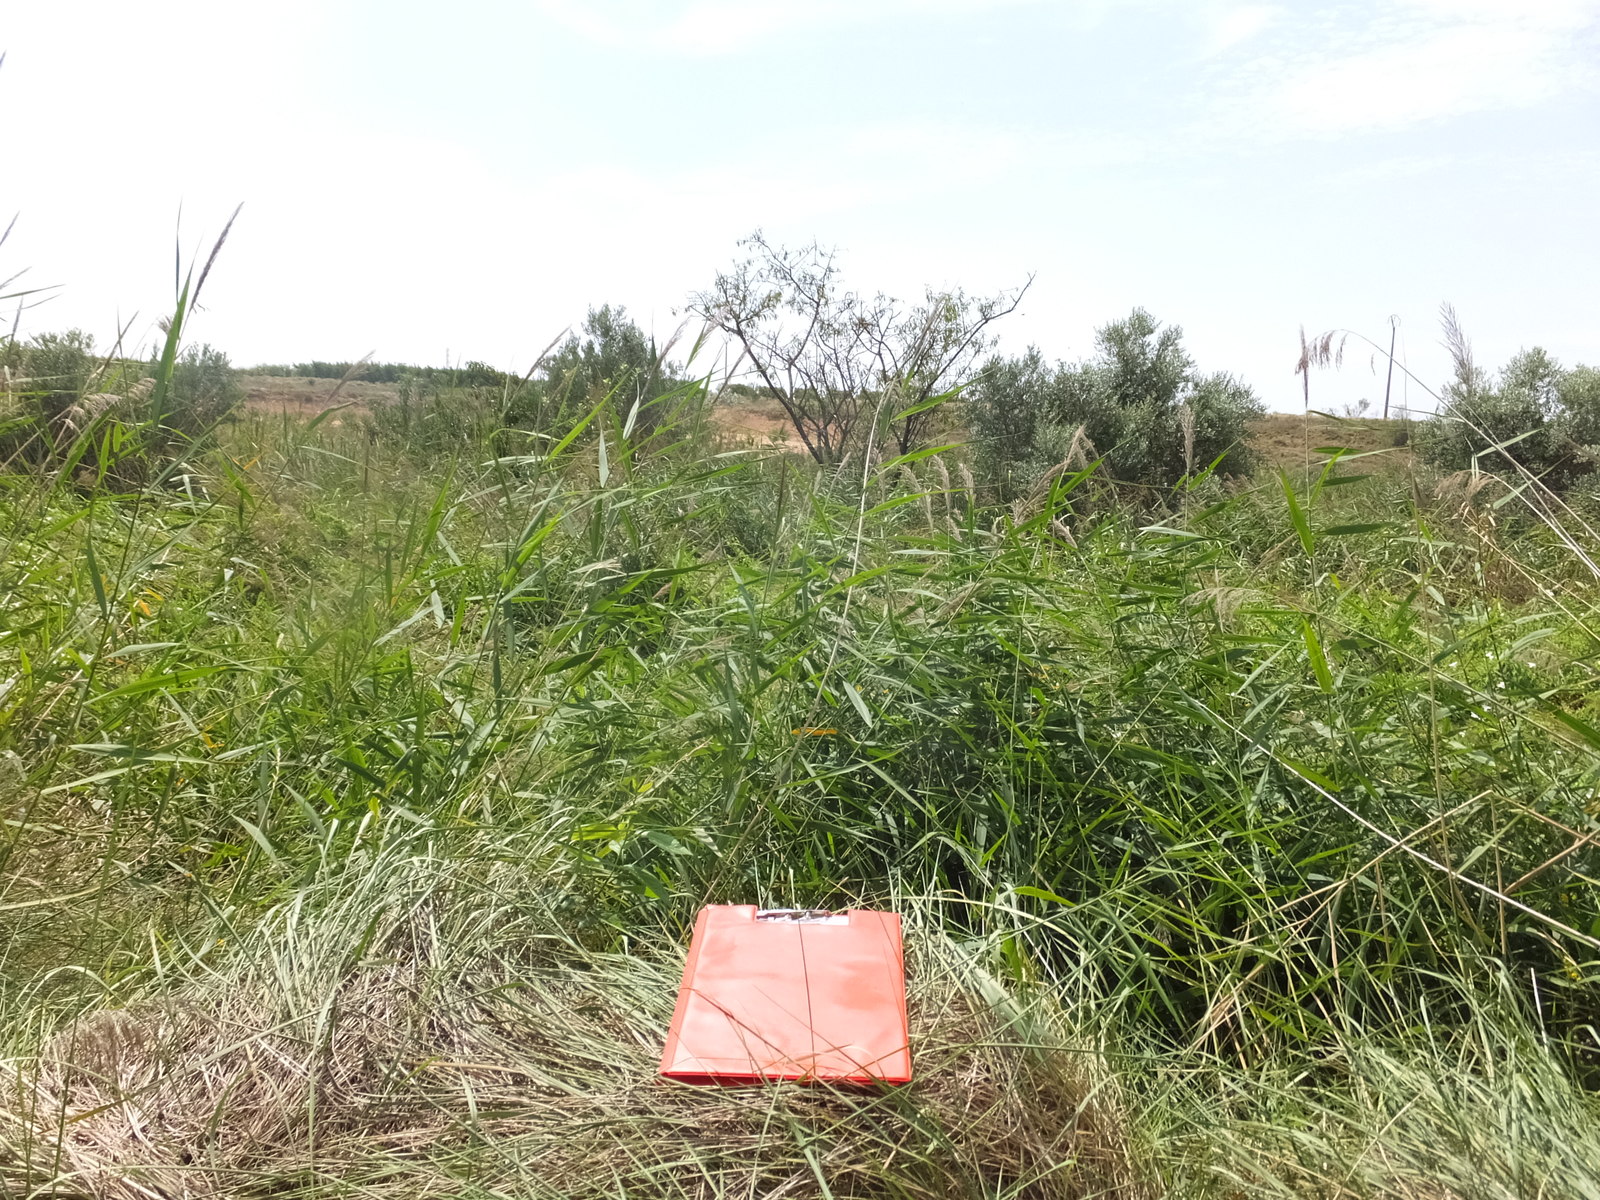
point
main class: Grassland
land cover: Grassland without tree/shrub cover
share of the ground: > 75 %
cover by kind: herbaceous plants 100 %
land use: Semi-natural and natural areas not in use
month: August
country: ES
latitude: 41.5747
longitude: 0.3561
